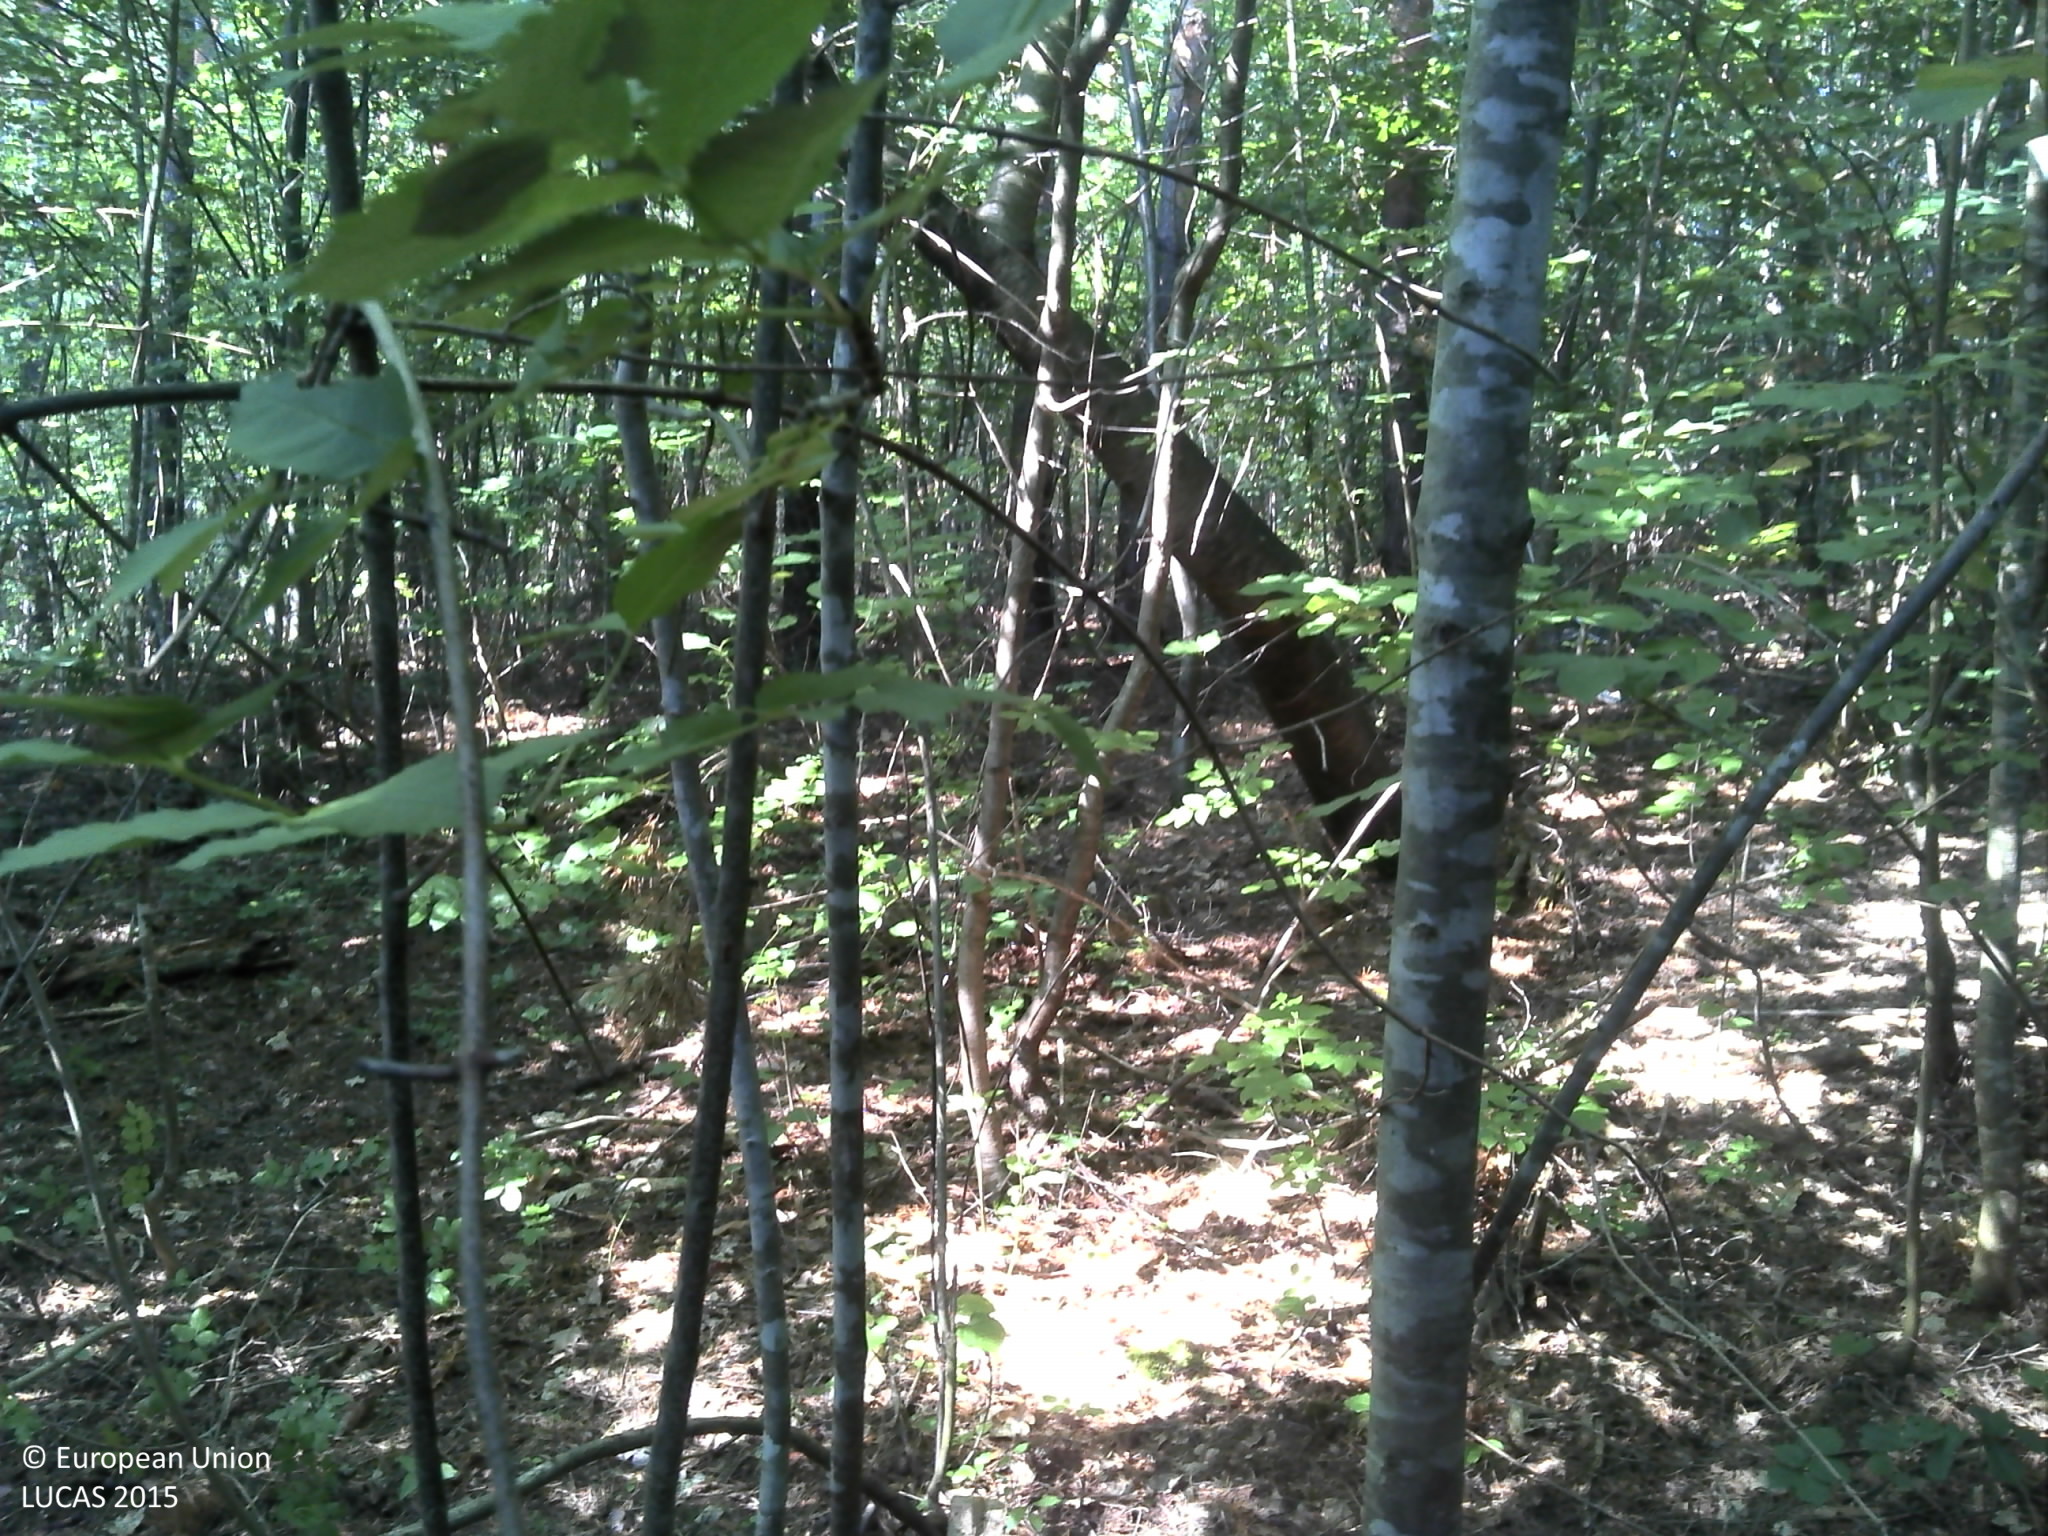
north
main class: Woodland
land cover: Broadleaved woodland
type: beech forest
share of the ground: > 75 %
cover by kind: broadleaved forest trees 100 %
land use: Forestry
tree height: > 5 m
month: June
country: HR
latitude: 45.4609
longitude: 17.6625
